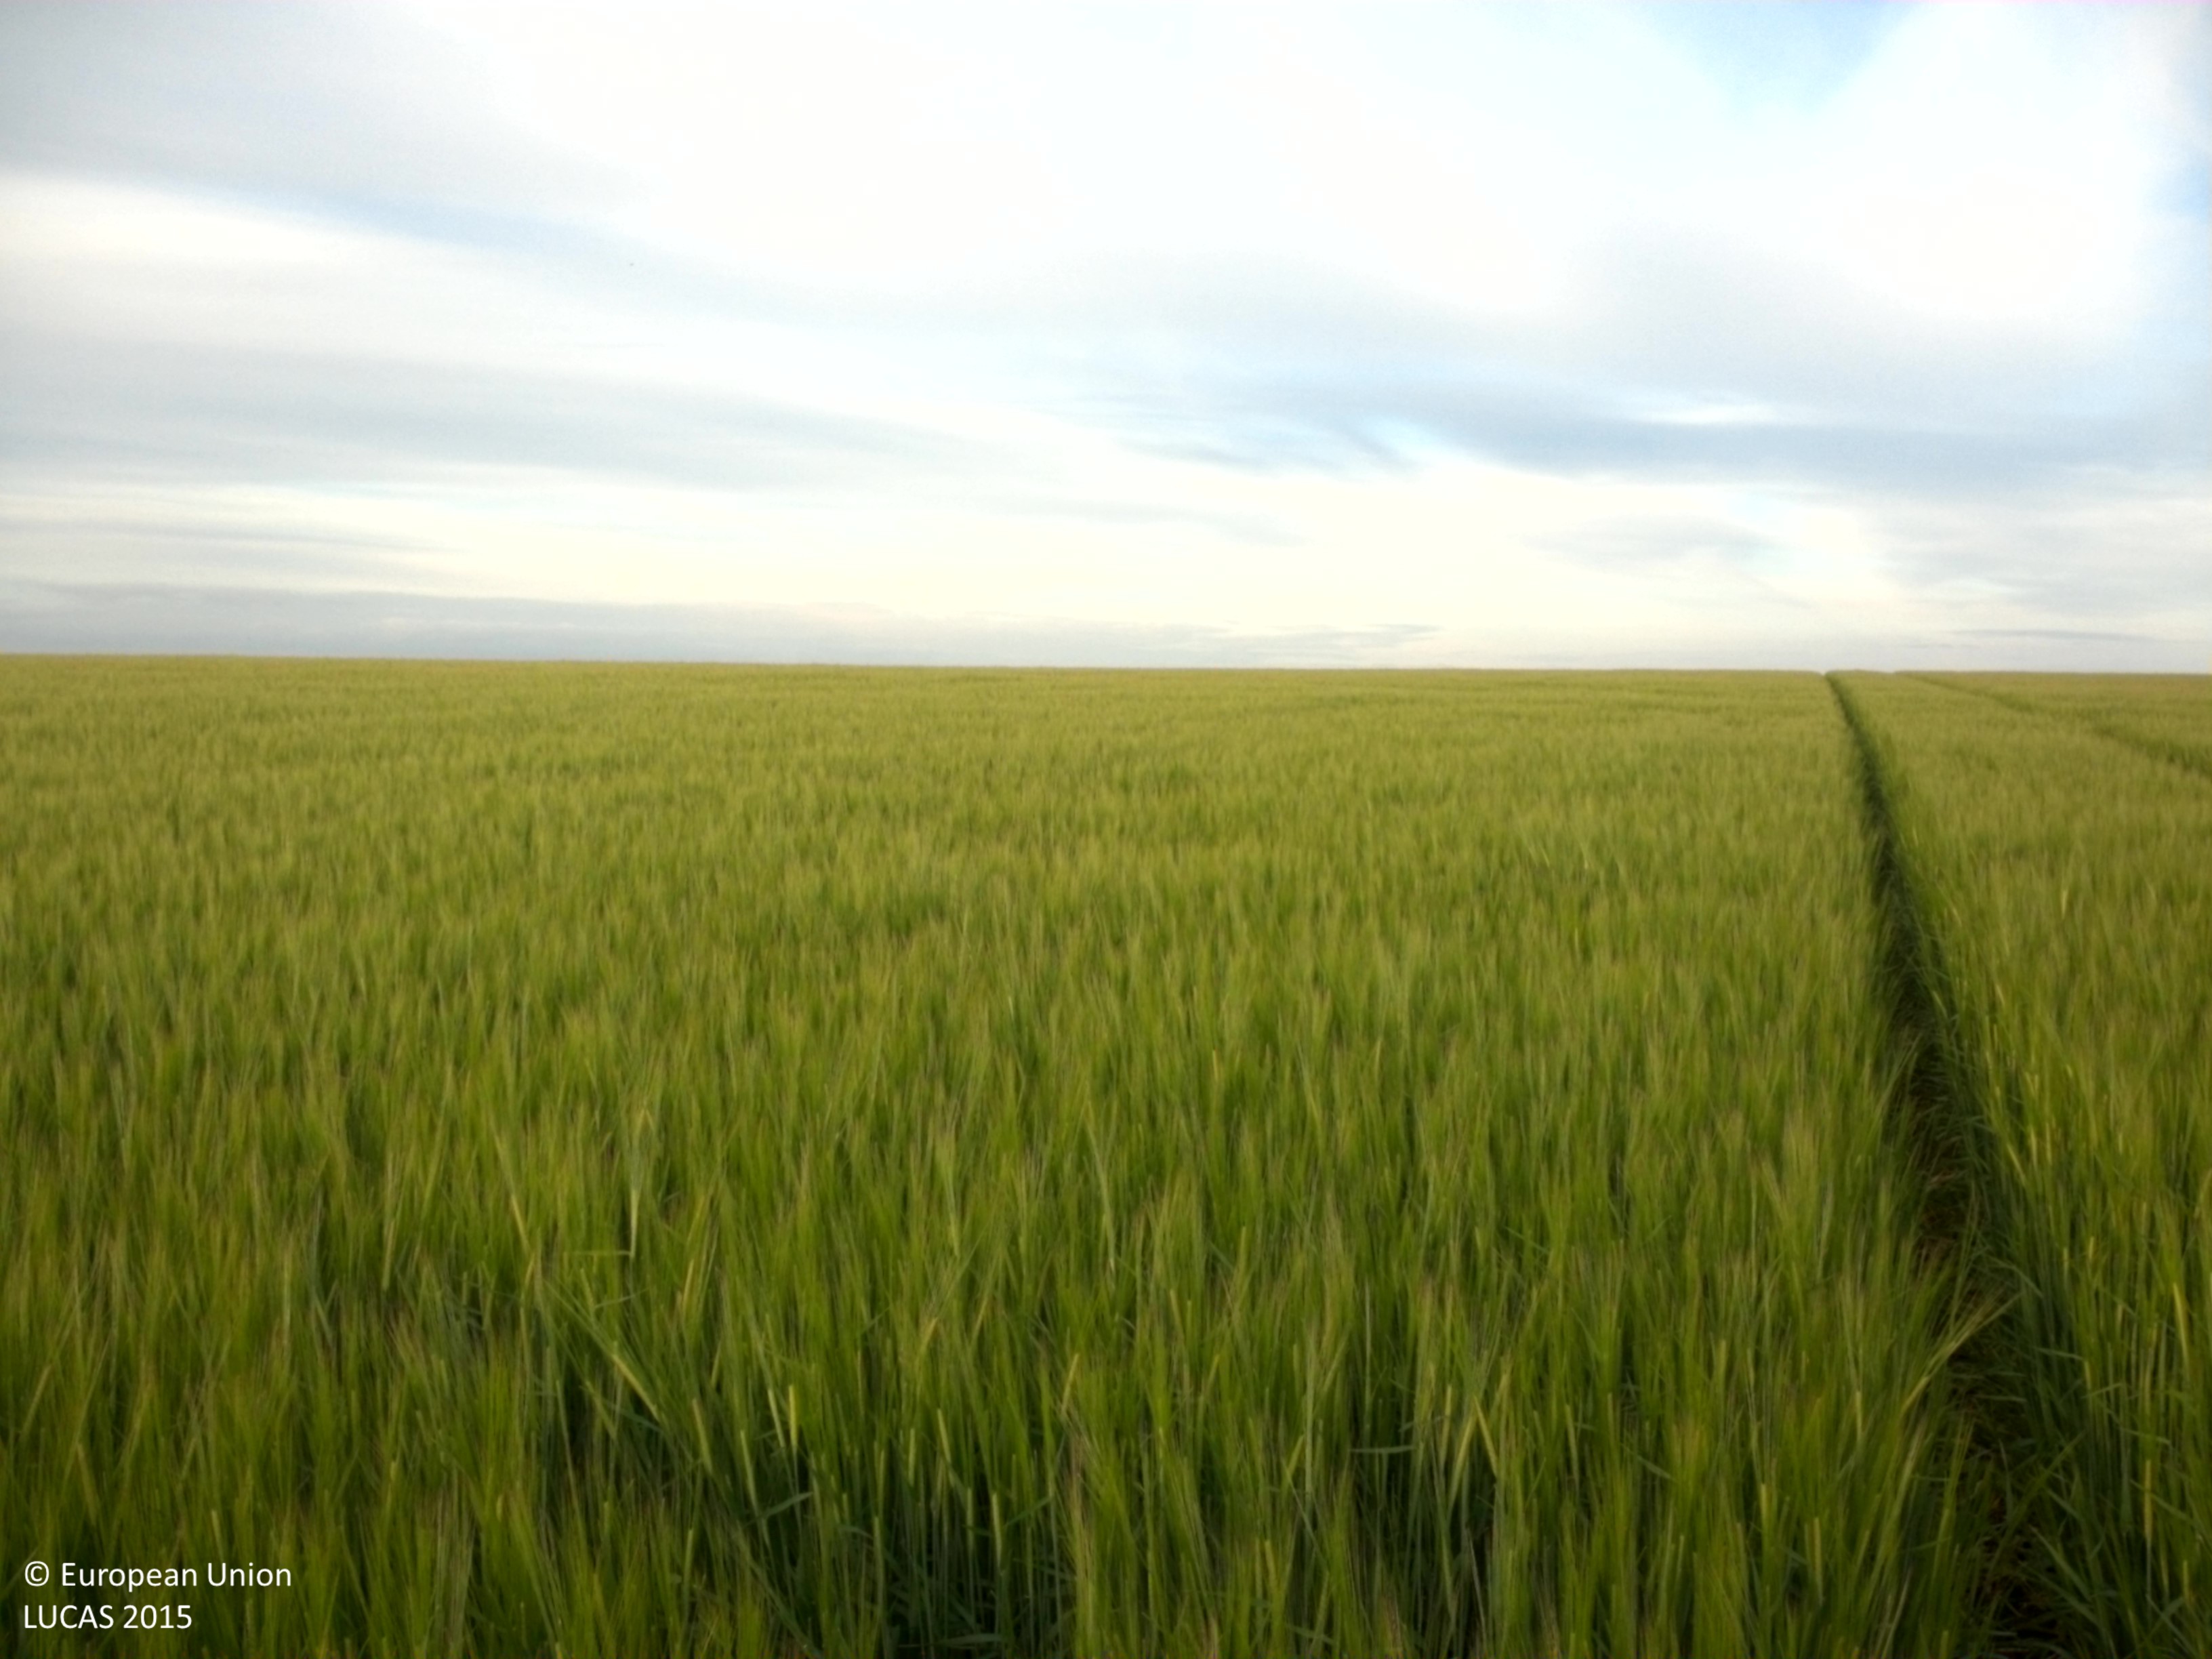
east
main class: Cropland
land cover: Barley
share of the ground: > 75 %
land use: Agriculture (excluding fallow land and kitchen gardens)
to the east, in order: Barley
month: June
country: SE
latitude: 55.4305
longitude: 13.1113
